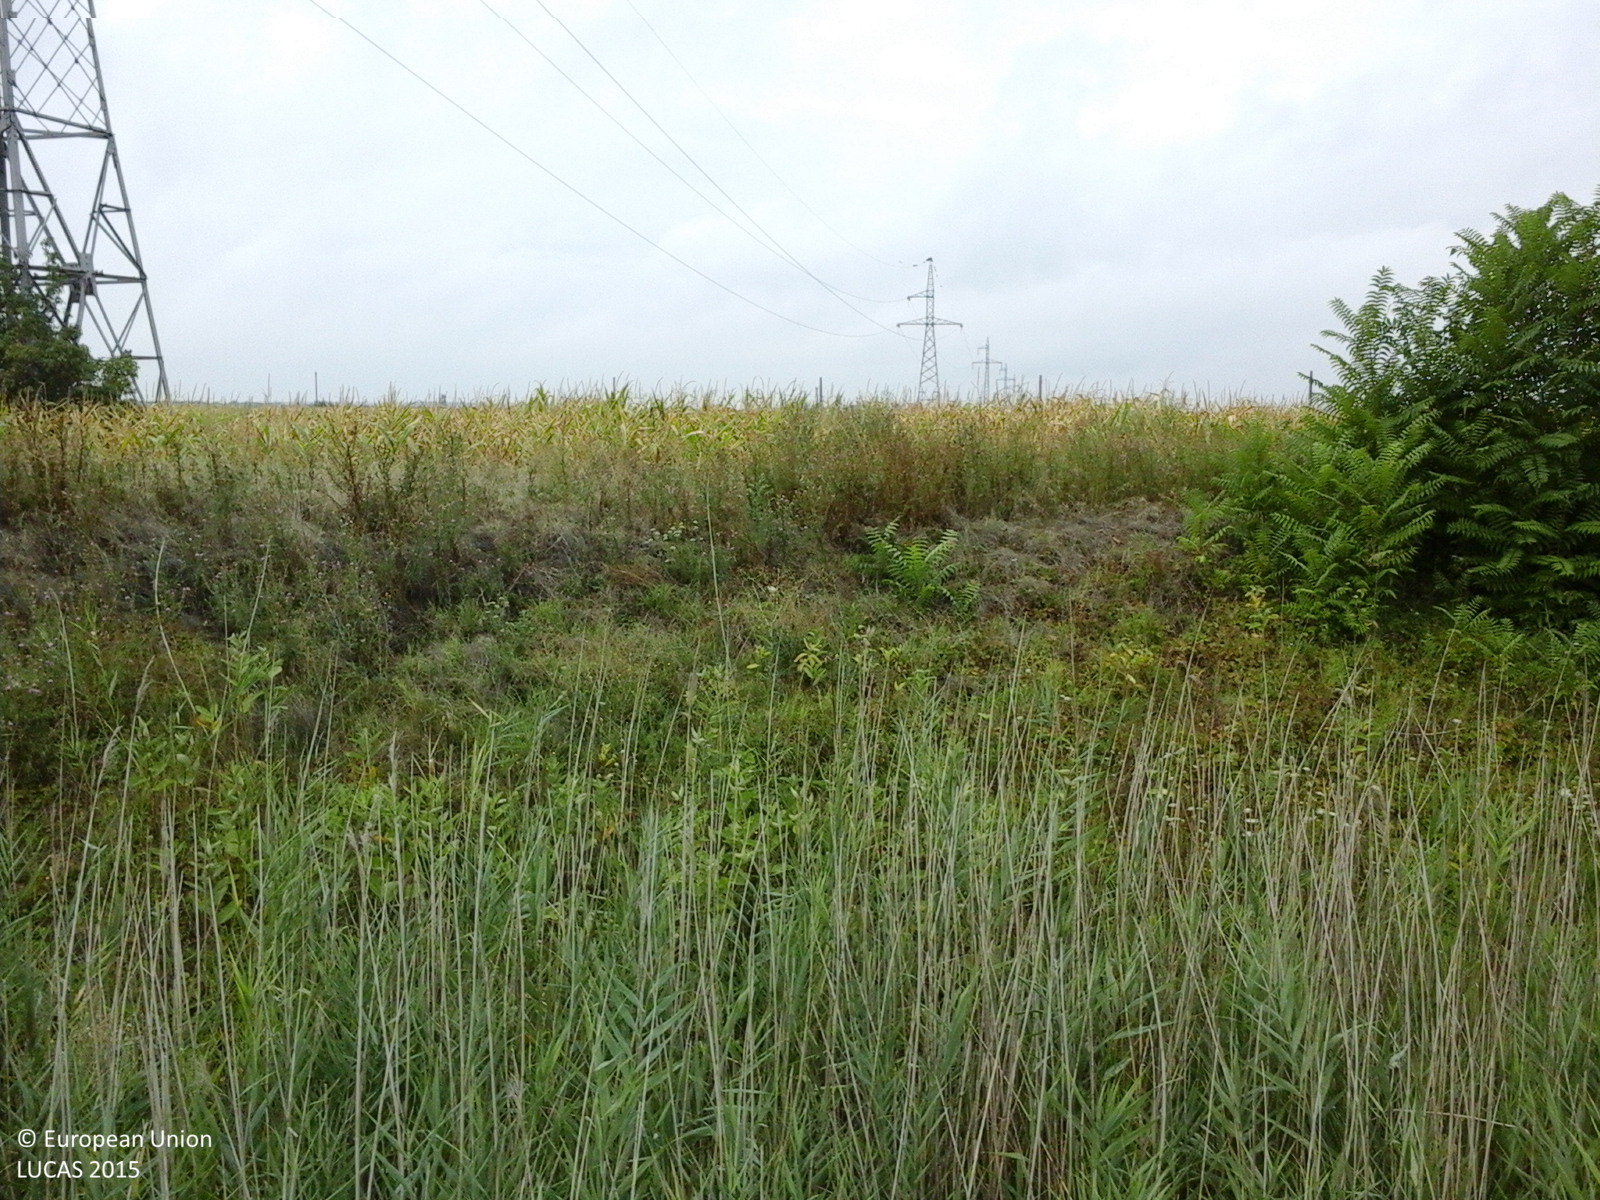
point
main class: Cropland
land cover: Maize
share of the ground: > 75 %
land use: Agriculture (excluding fallow land and kitchen gardens)
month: August
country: RO
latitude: 45.8135
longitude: 20.6937
